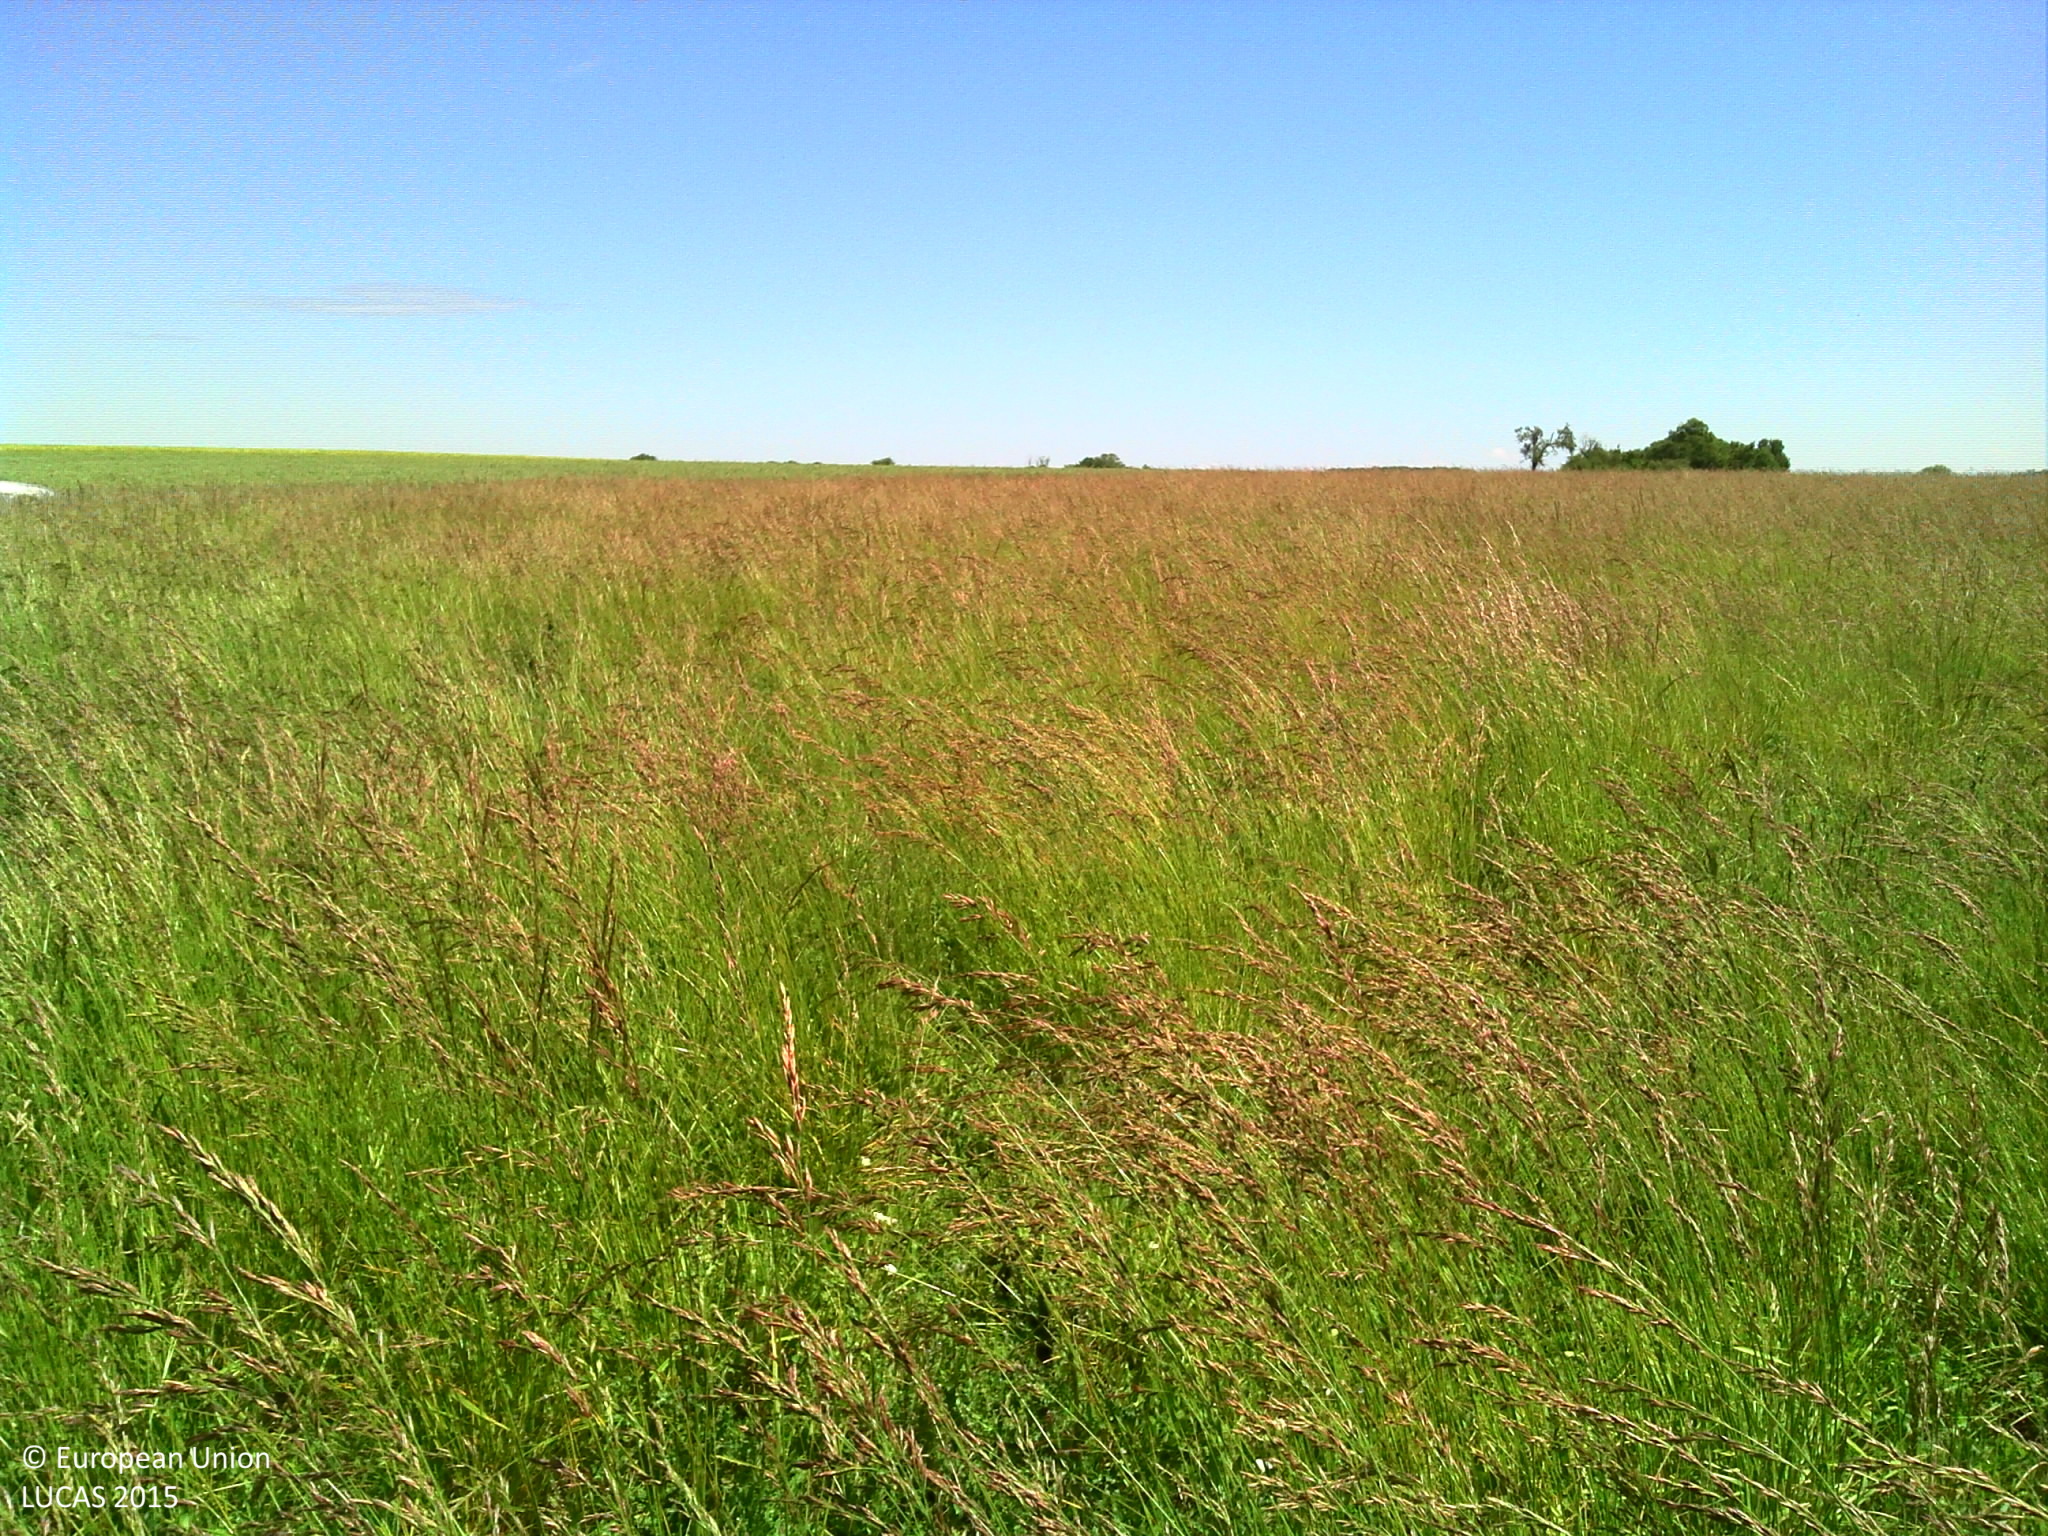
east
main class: Grassland
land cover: Grassland without tree/shrub cover
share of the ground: > 75 %
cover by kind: herbaceous plants 100 %
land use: Agriculture (excluding fallow land and kitchen gardens)
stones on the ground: 10 - 25 %
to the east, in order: Grassland without tree/shrub cover; Common wheat; Grass margins; Tracks; Grass margins; Barley
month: June
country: FR
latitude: 47.0642
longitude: 2.7659
